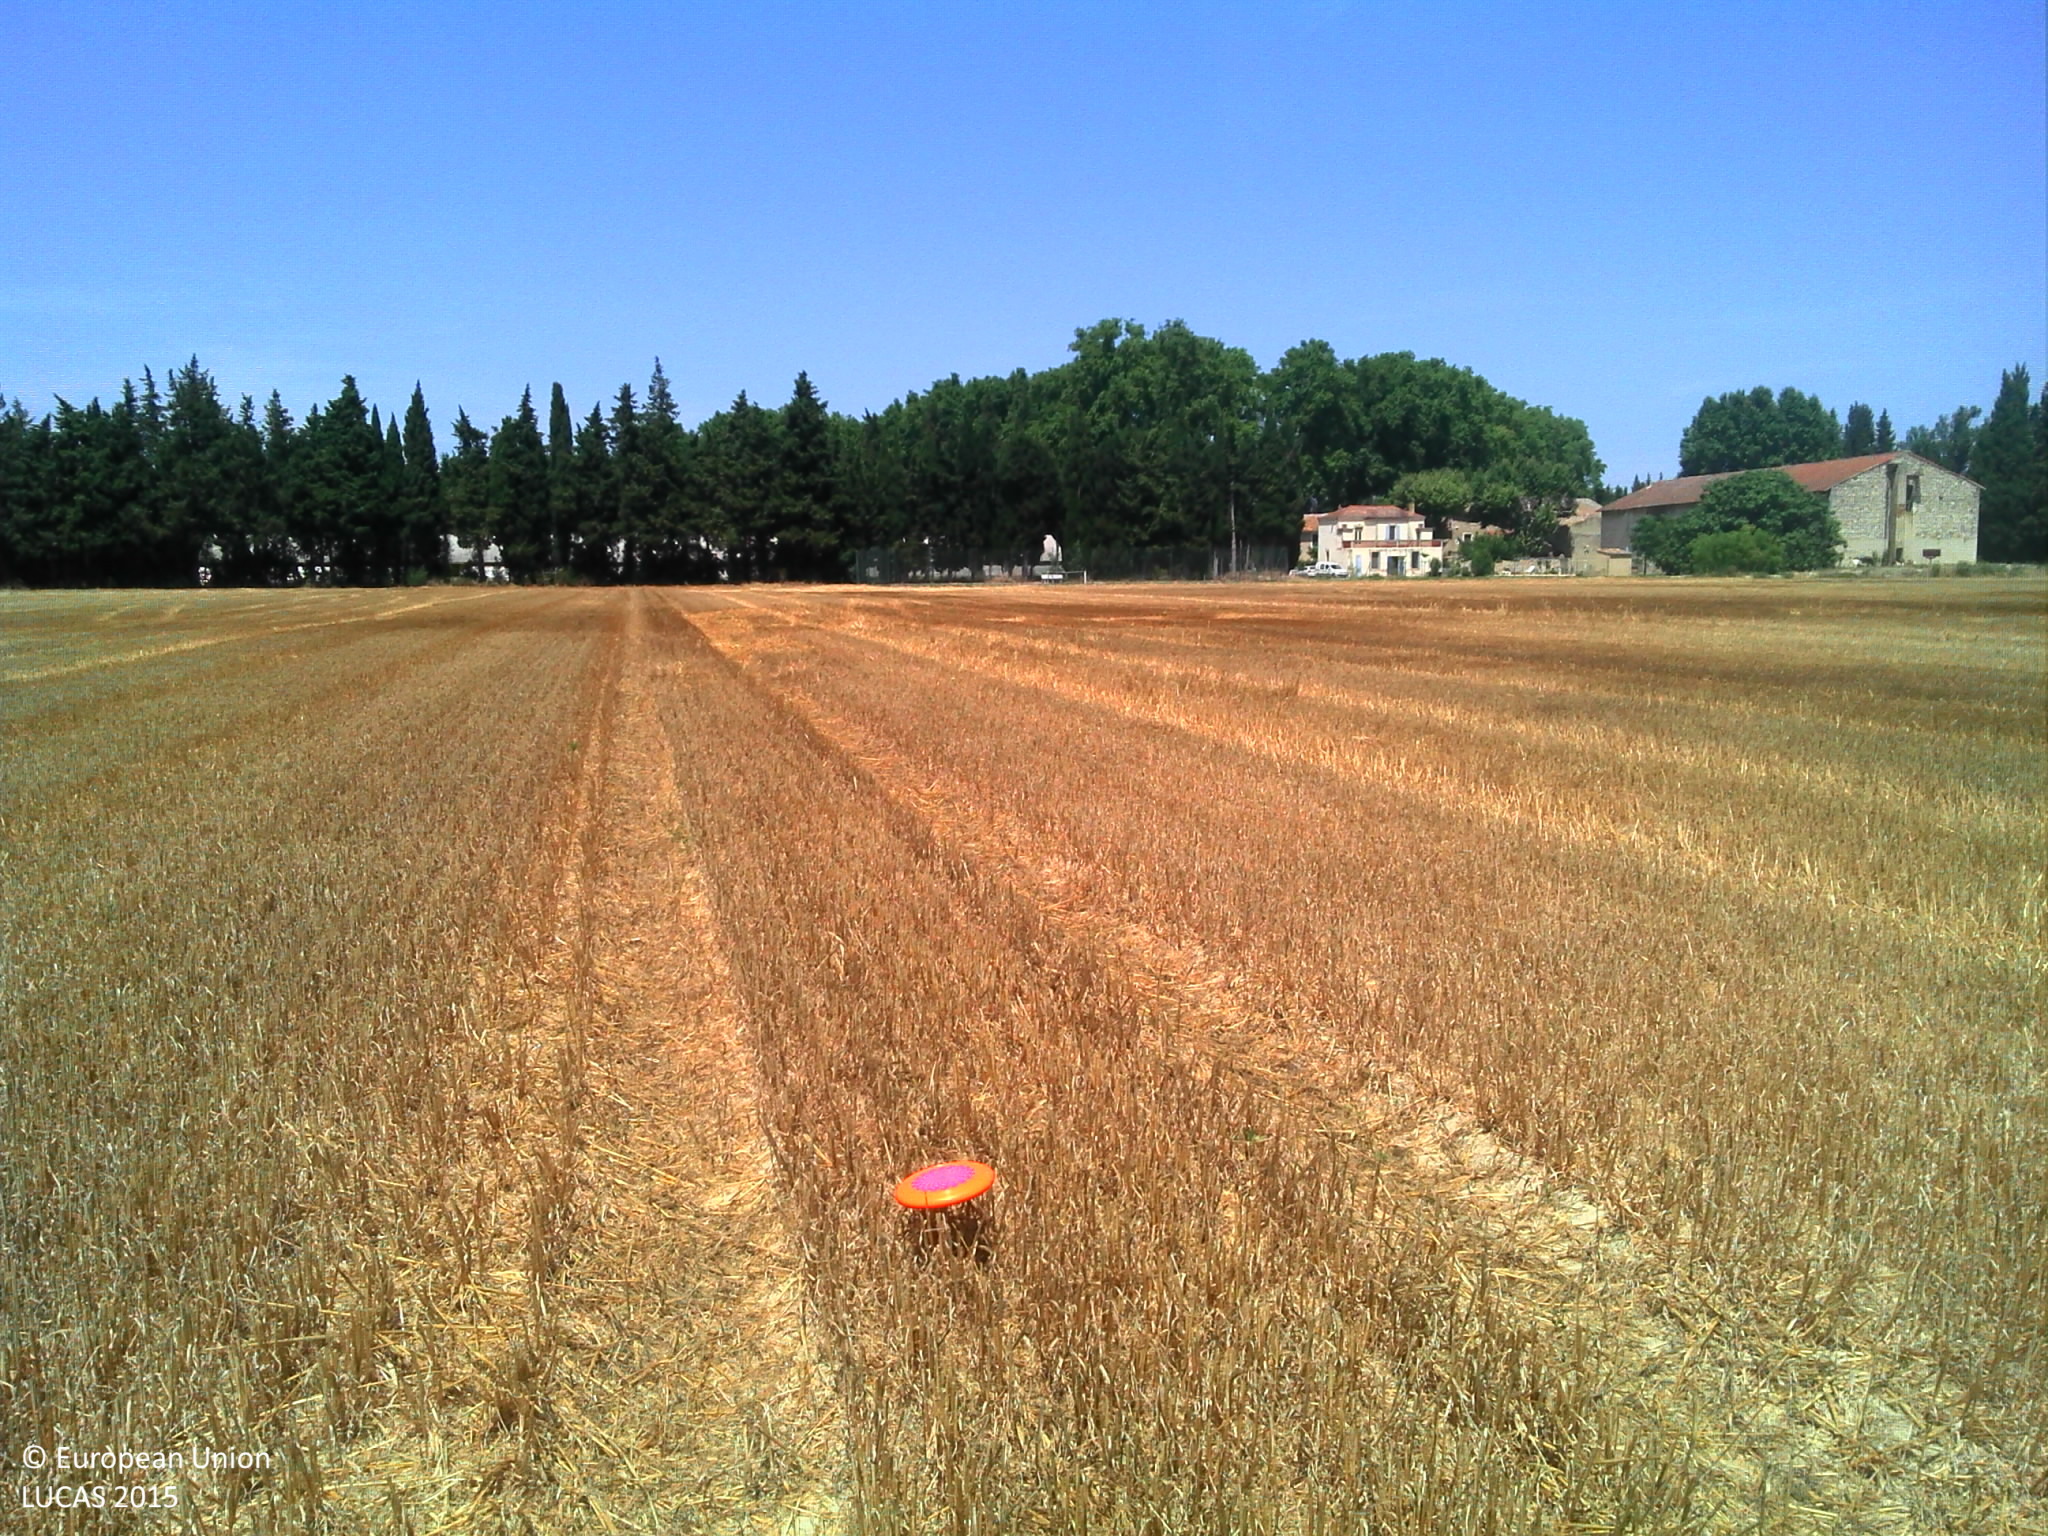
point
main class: Cropland
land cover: Durum wheat
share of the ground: > 75 %
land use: Agriculture (excluding fallow land and kitchen gardens)
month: July
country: FR
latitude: 43.8380
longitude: 4.7480
